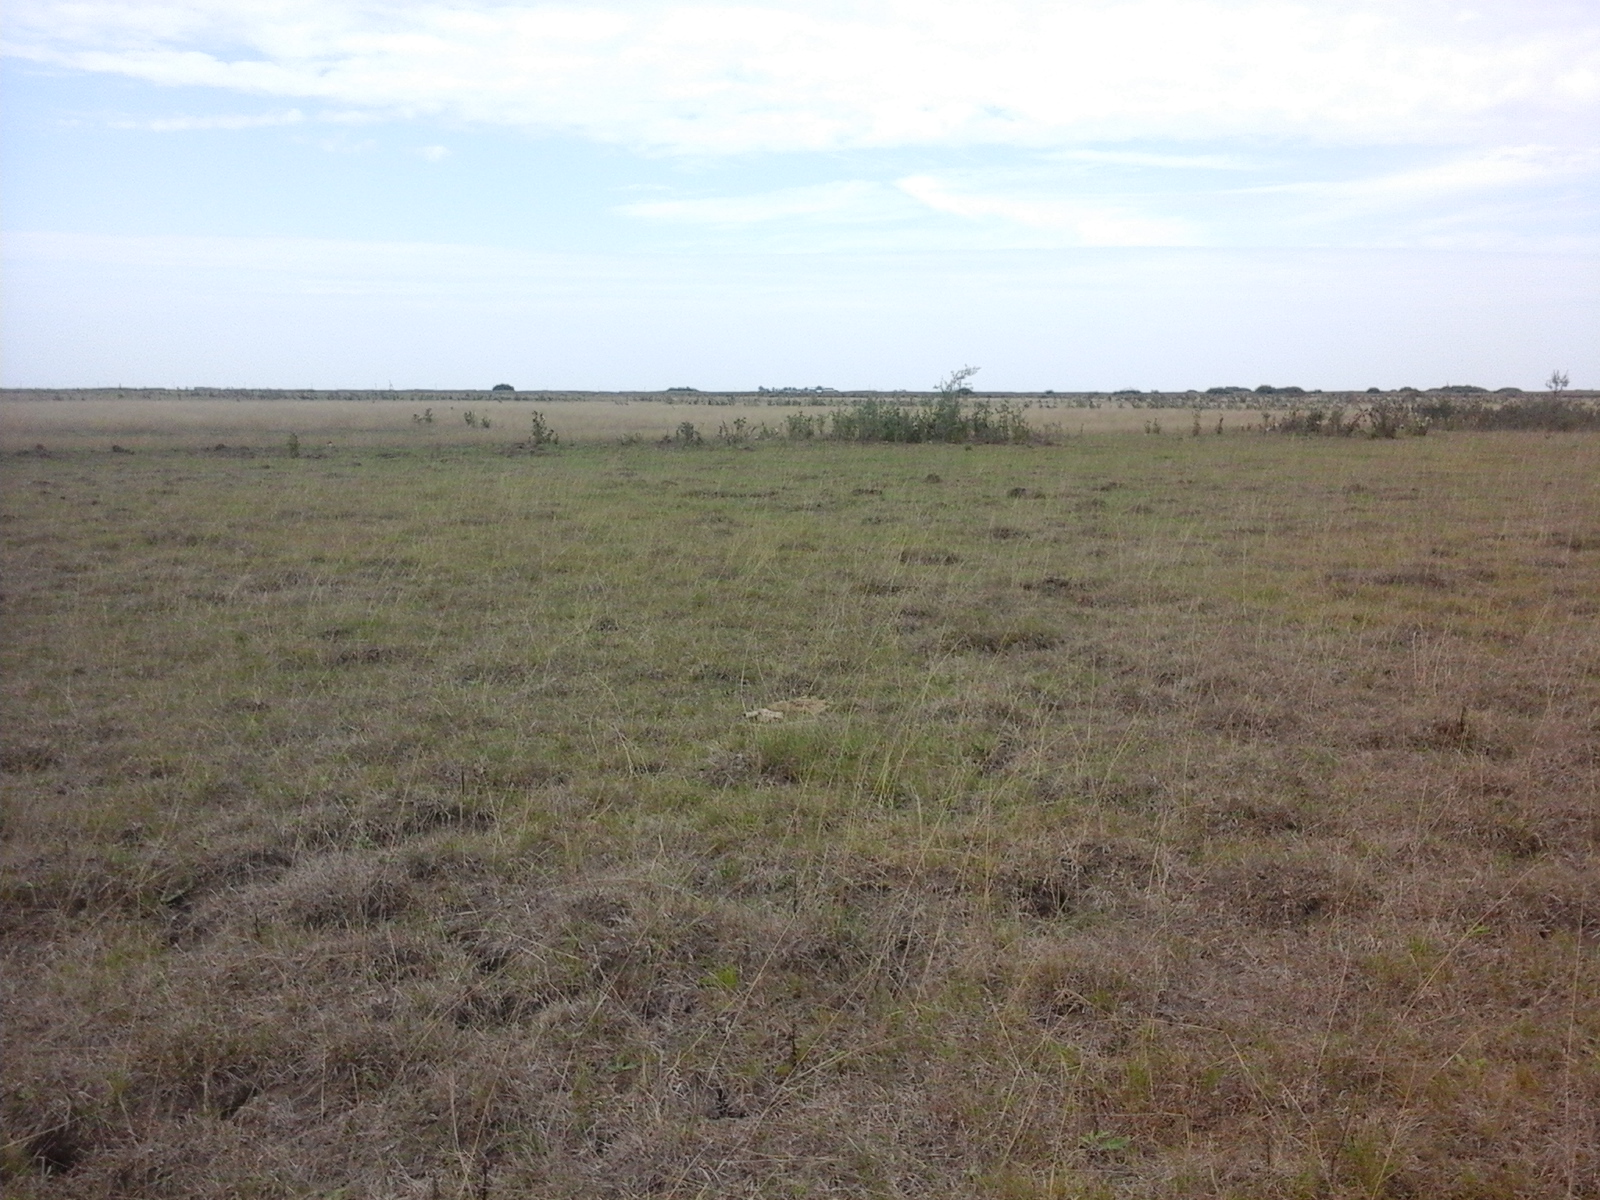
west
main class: Grassland
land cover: Grassland without tree/shrub cover
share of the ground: > 75 %
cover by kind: herbaceous plants 100 %
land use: Agriculture (excluding fallow land and kitchen gardens)
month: August
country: RO
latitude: 46.5374
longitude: 21.4202
